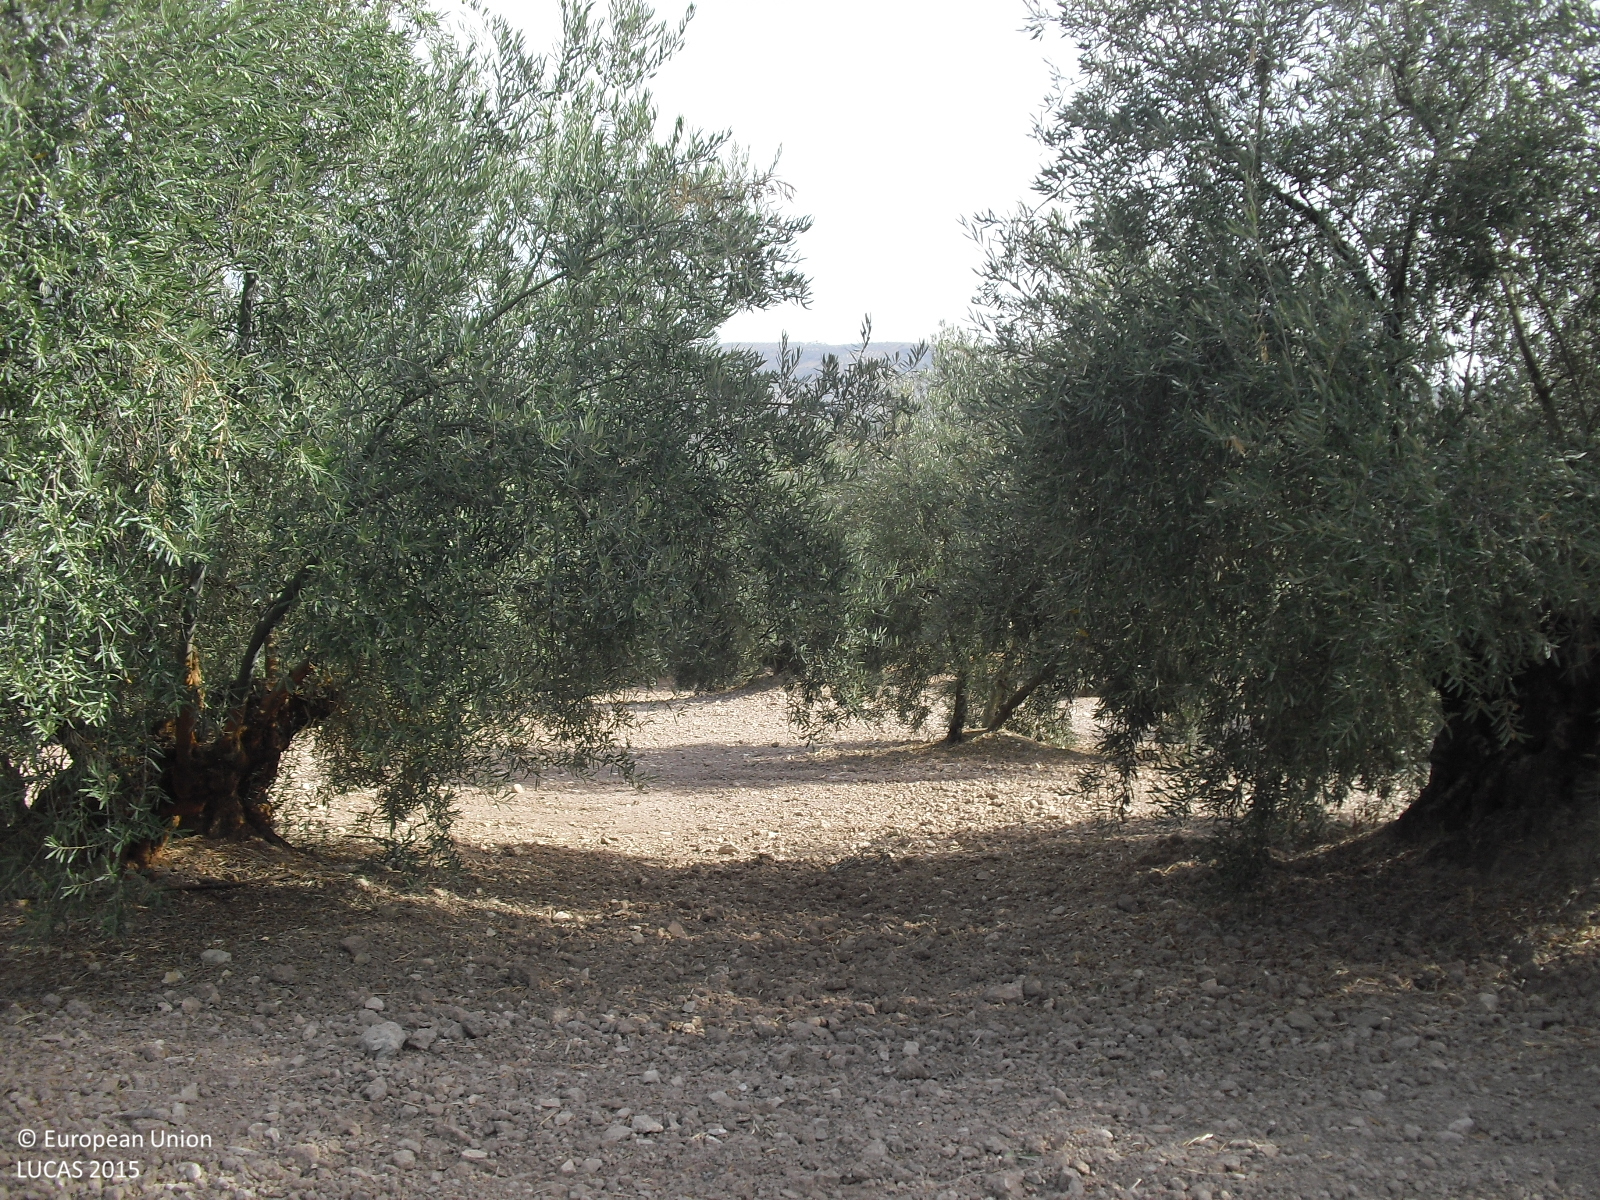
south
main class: Cropland
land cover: Olive groves
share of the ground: 25 - 50 %
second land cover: Other bare soil
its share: > 75 %
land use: Agriculture (excluding fallow land and kitchen gardens)
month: August
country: ES
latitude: 37.2849
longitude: -4.4259
